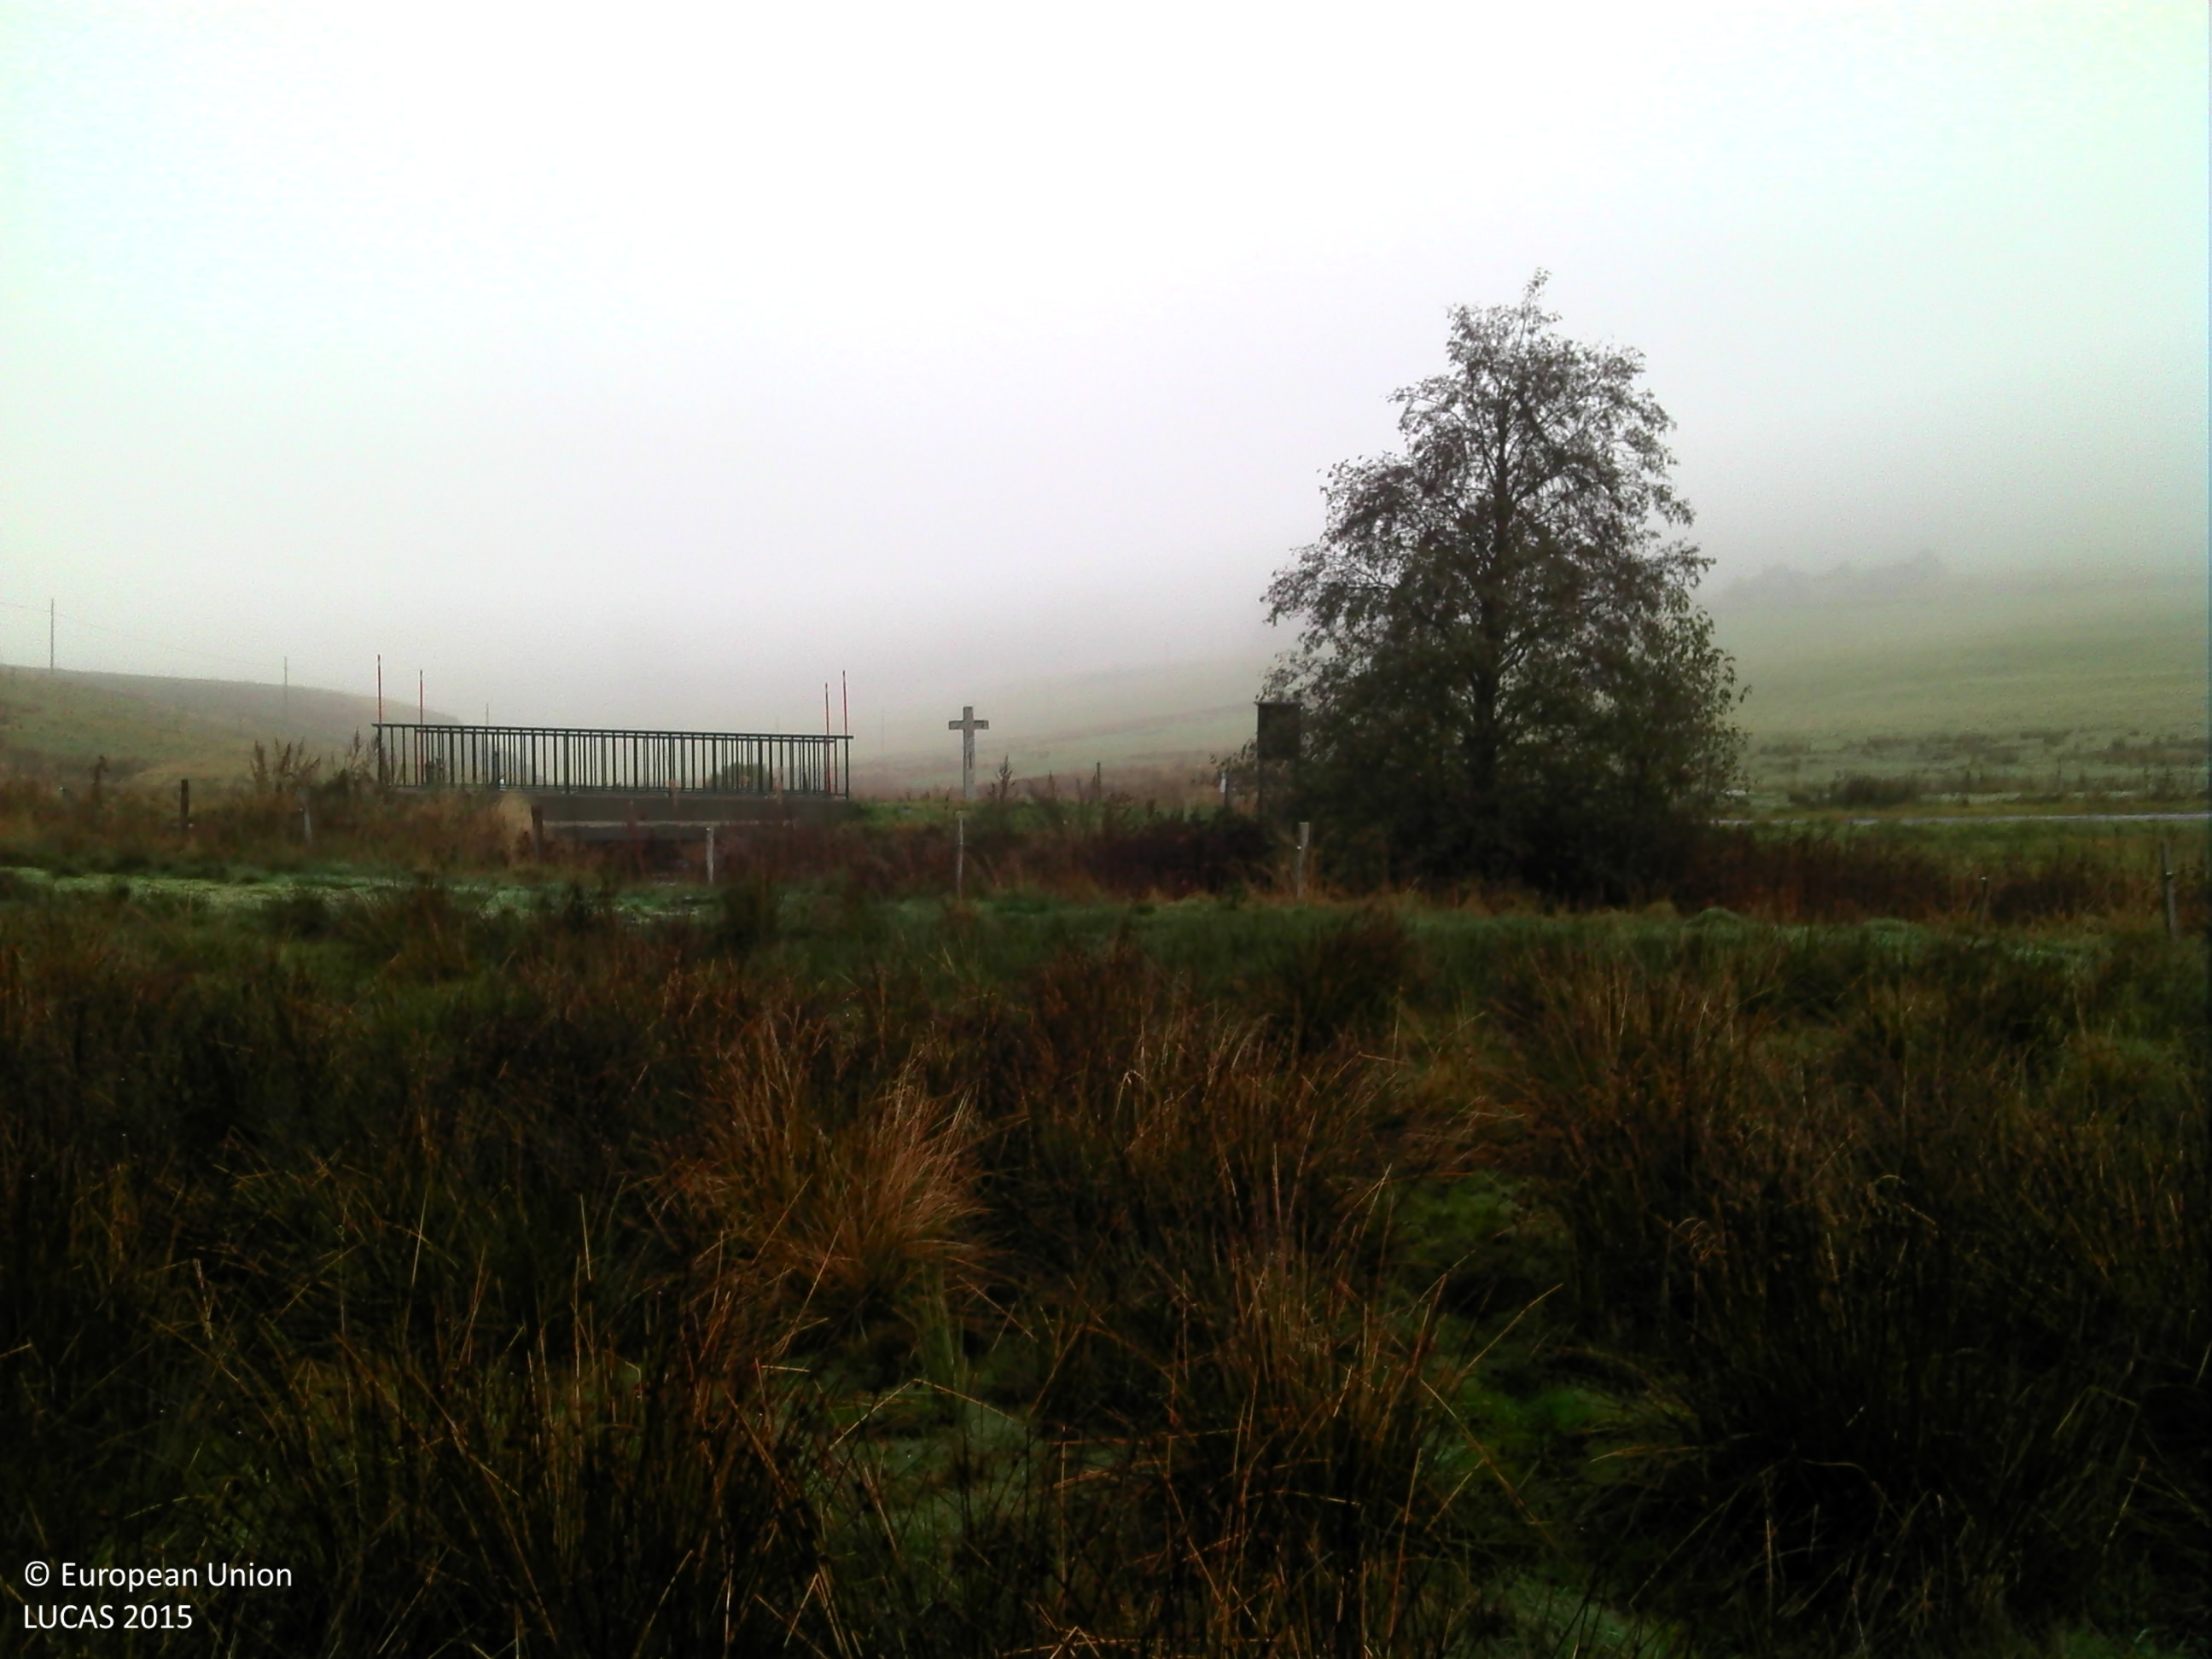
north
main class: Grassland
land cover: Grassland without tree/shrub cover
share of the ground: > 75 %
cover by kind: herbaceous plants 100 %
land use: Agriculture (excluding fallow land and kitchen gardens)
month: October
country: FR
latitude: 44.9468
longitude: 4.1875
